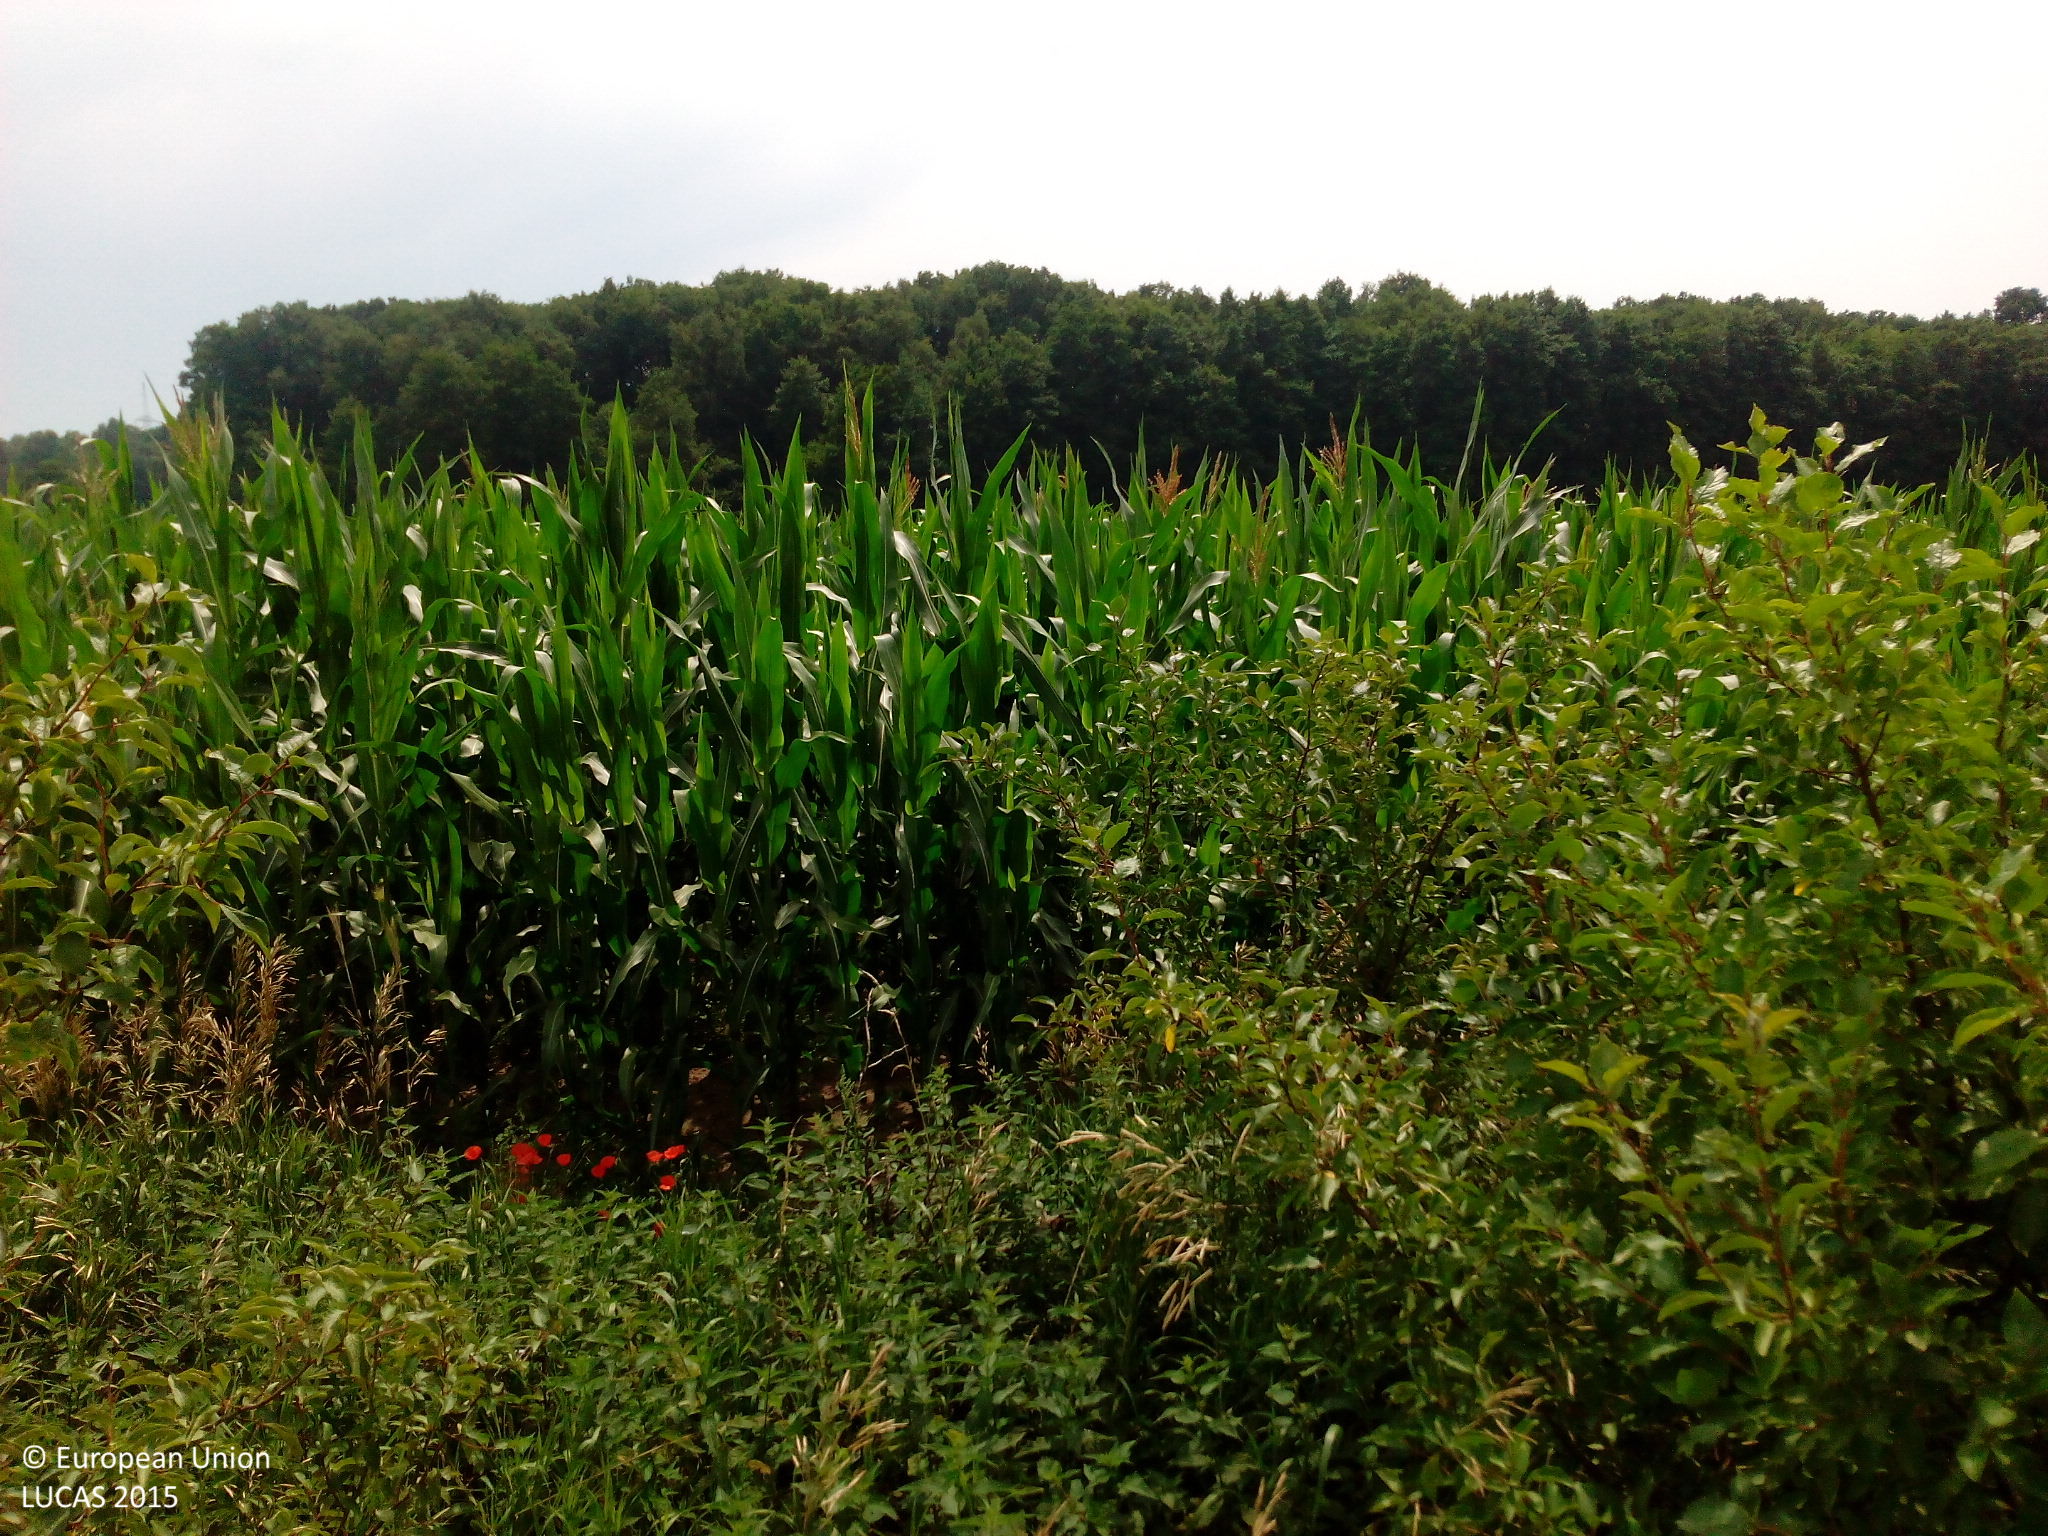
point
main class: Cropland
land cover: Maize
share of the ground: > 75 %
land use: Agriculture (excluding fallow land and kitchen gardens)
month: July
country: DE
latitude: 52.4831
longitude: 12.1936
